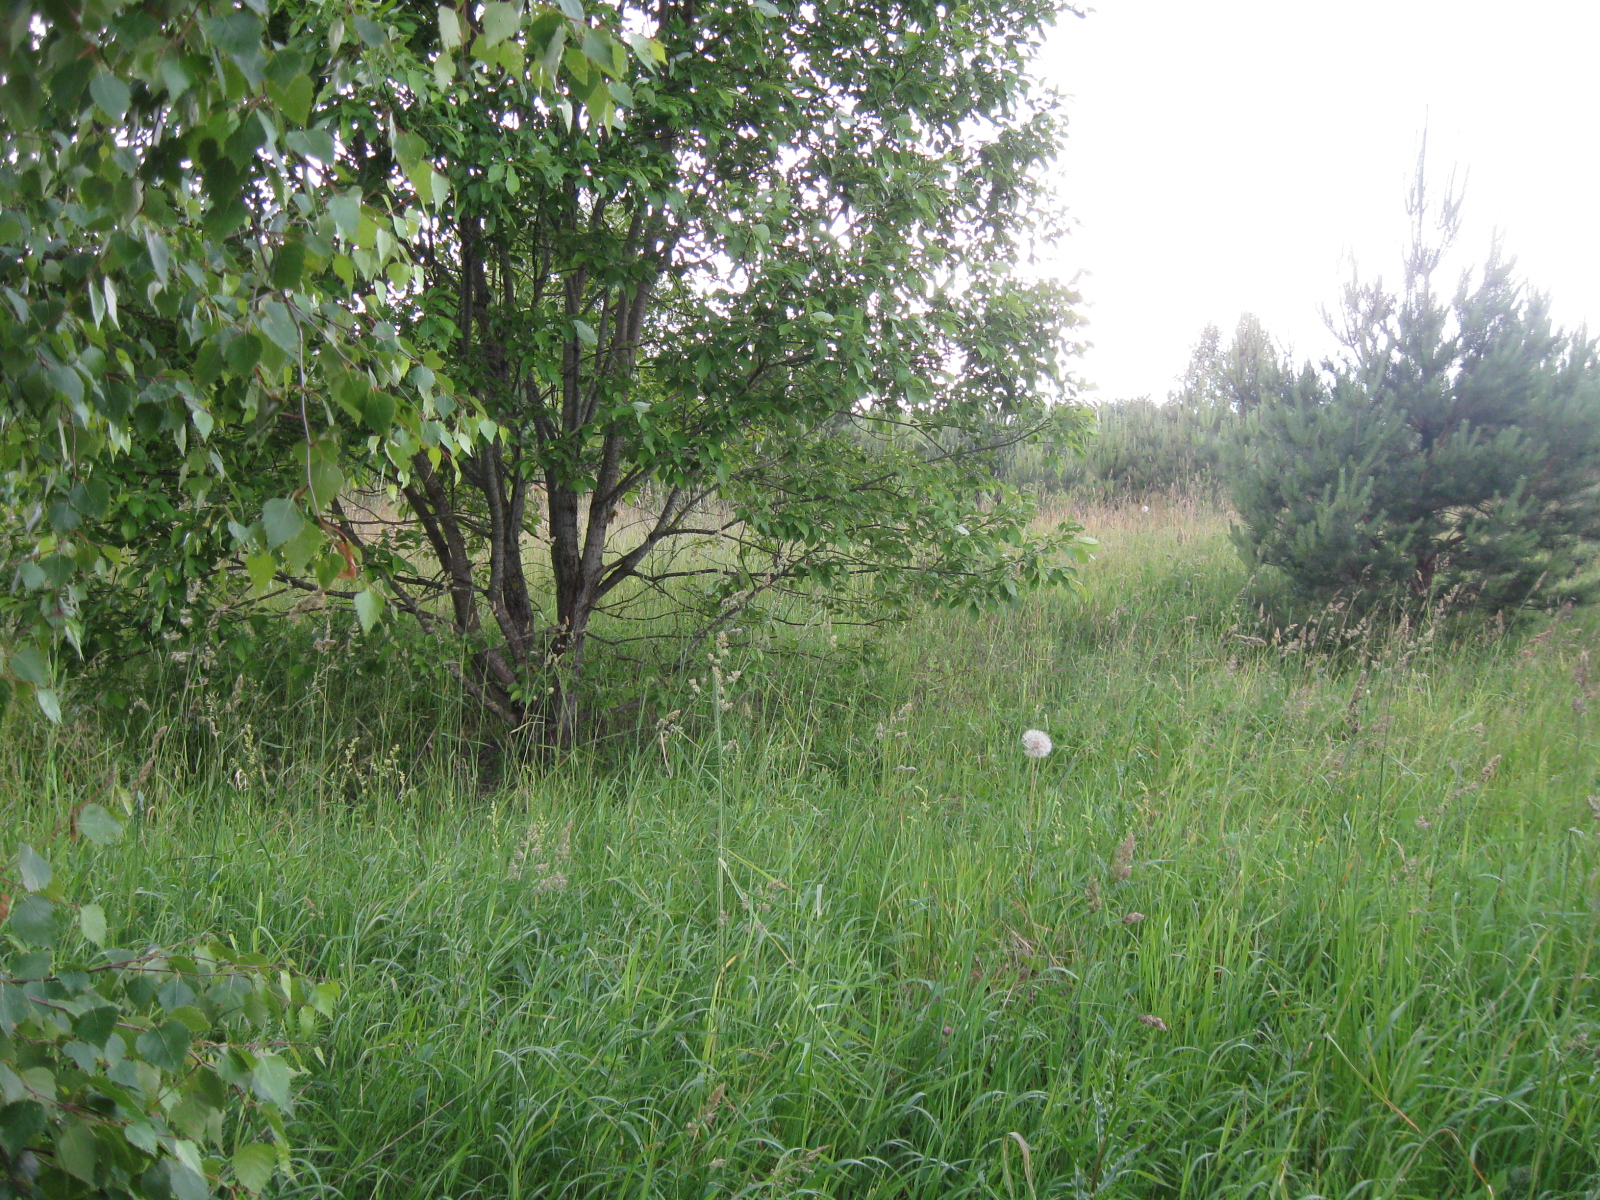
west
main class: Woodland
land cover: Pine dominated mixed woodland
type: hemiboreal forest and nemoral coniferous forest and mixed broadleaved-coniferous forest
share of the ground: 25 - 50 %
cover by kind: herbaceous plants 65 %, coniferous forest trees 20 %, broadleaved forest trees 15 %
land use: Forestry
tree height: < 5 m
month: June
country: LT
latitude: 54.5778
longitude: 24.4430
